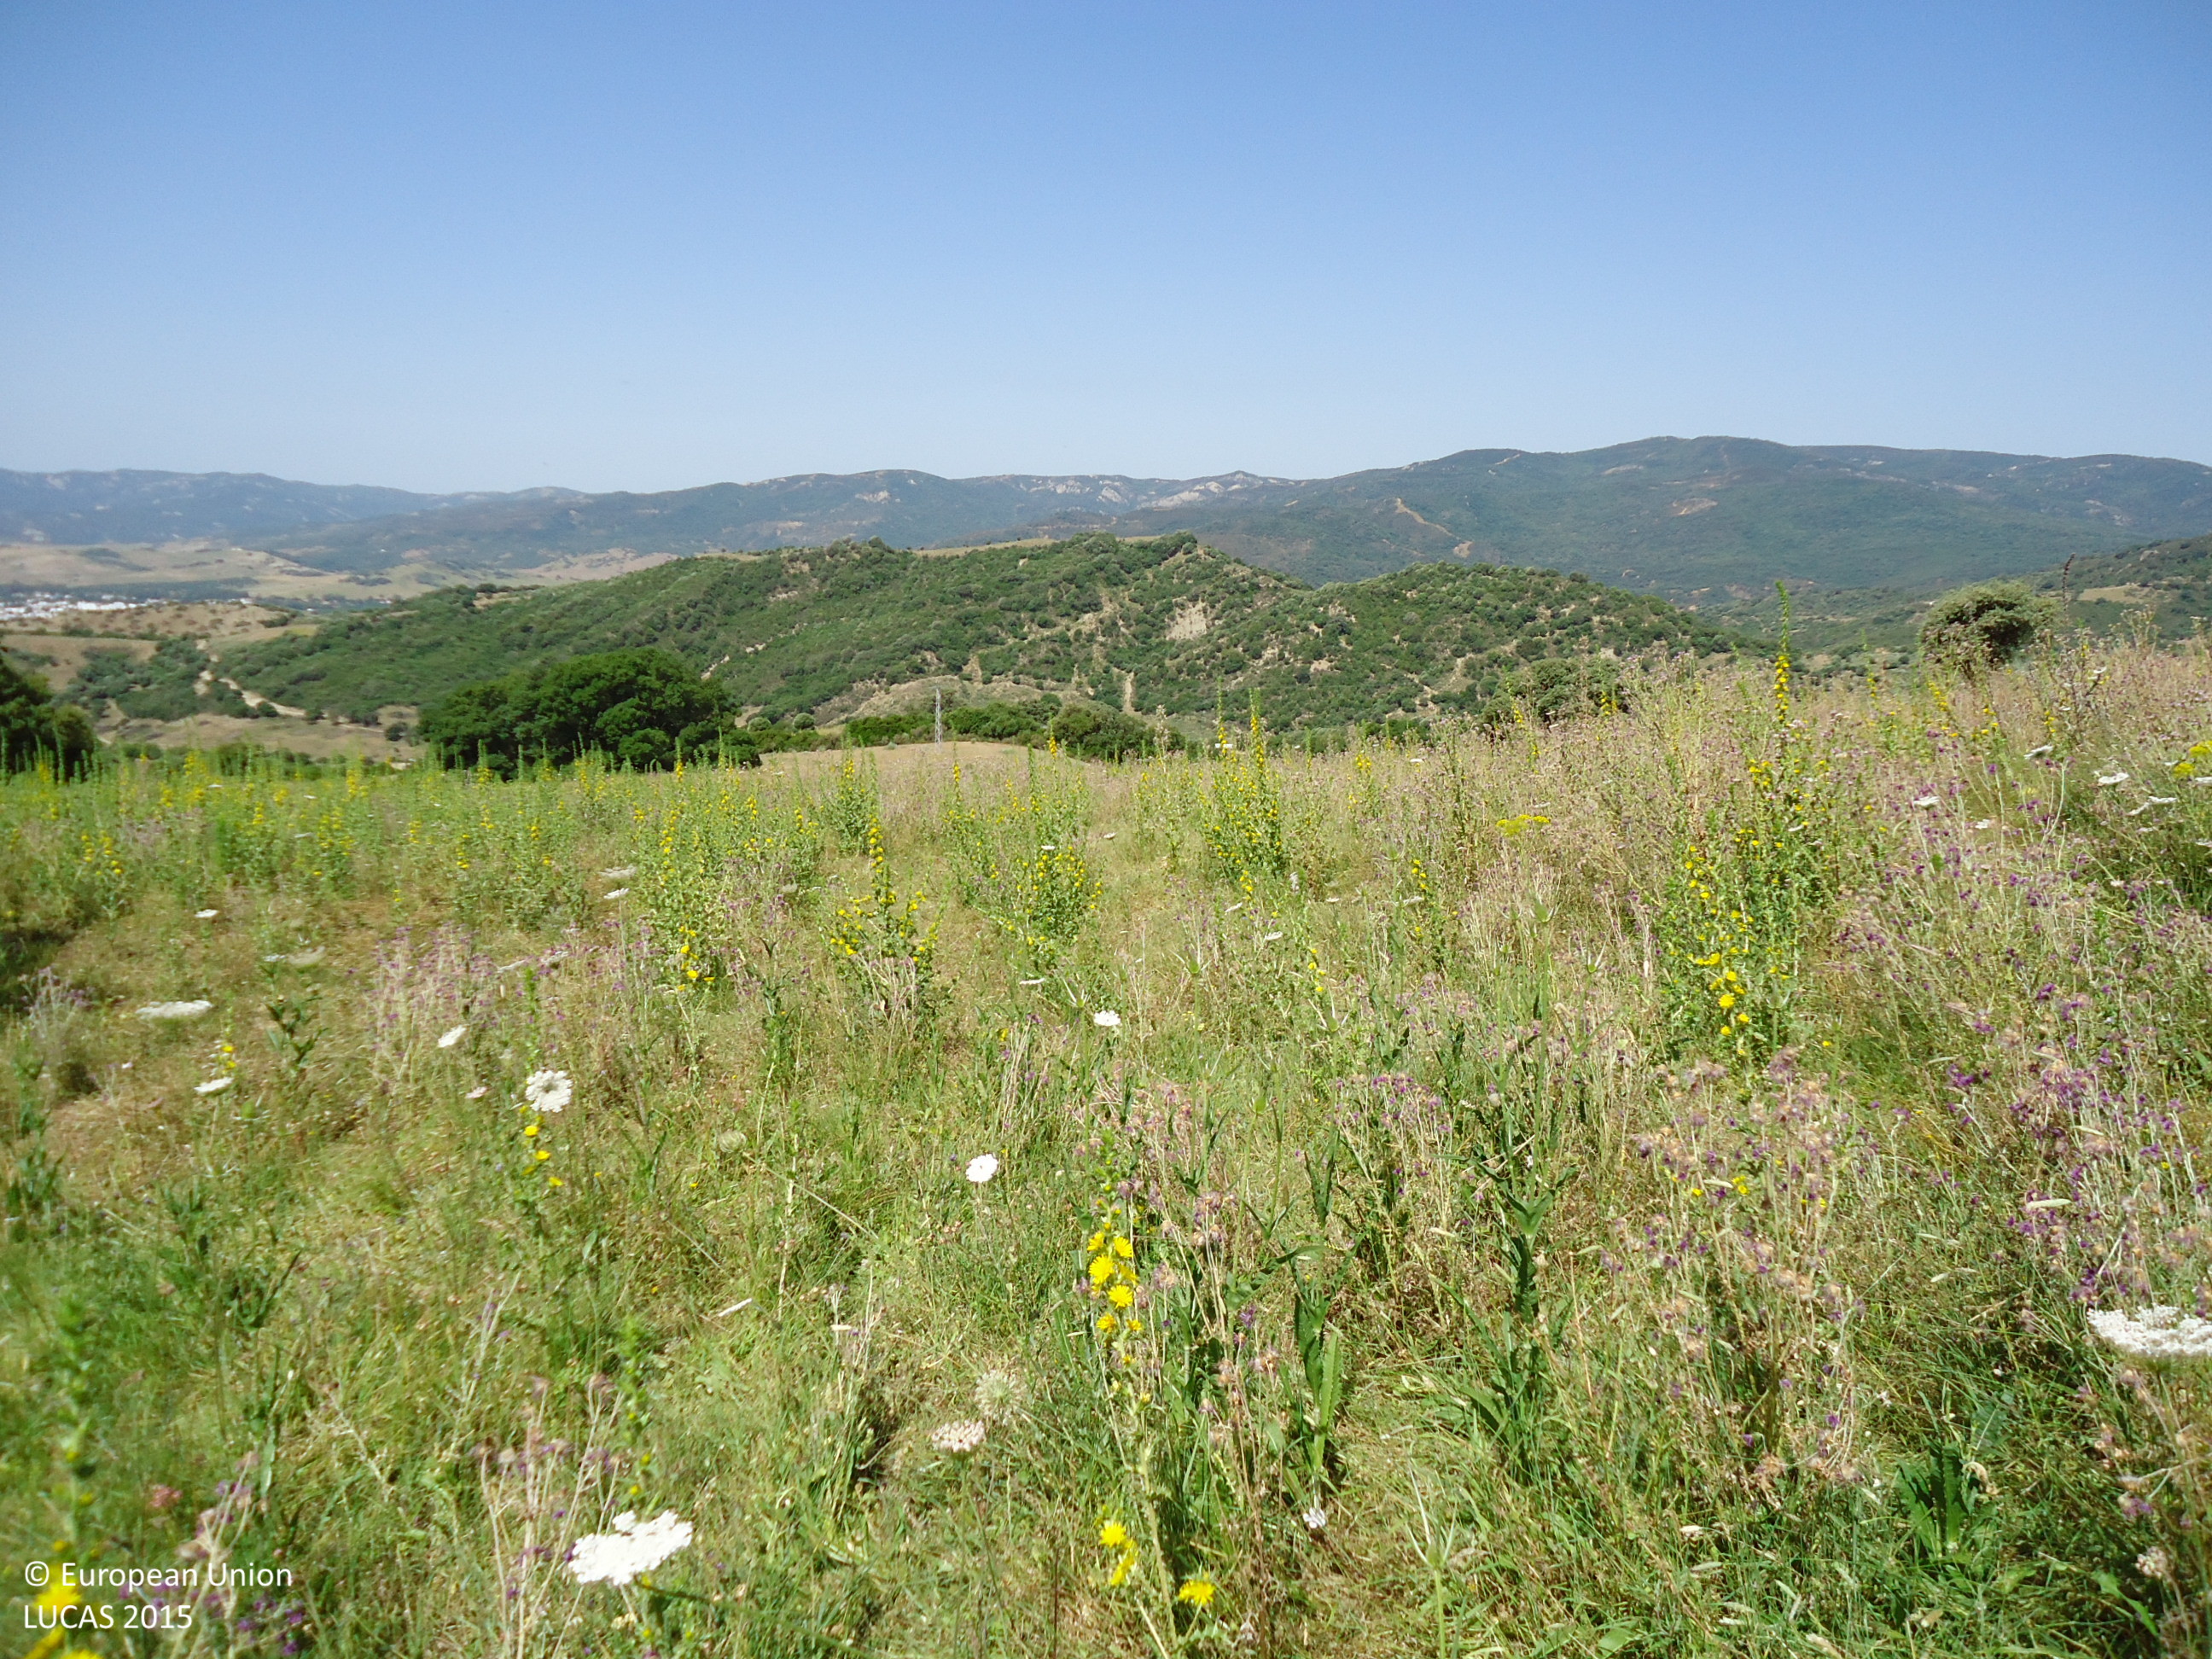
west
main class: Grassland
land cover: Grassland with sparse tree/shrub cover
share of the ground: > 75 %
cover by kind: herbaceous plants 95 %, broadleaved forest trees 5 %
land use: Agriculture (excluding fallow land and kitchen gardens)
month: June
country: ES
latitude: 36.4902
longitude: -5.3685
